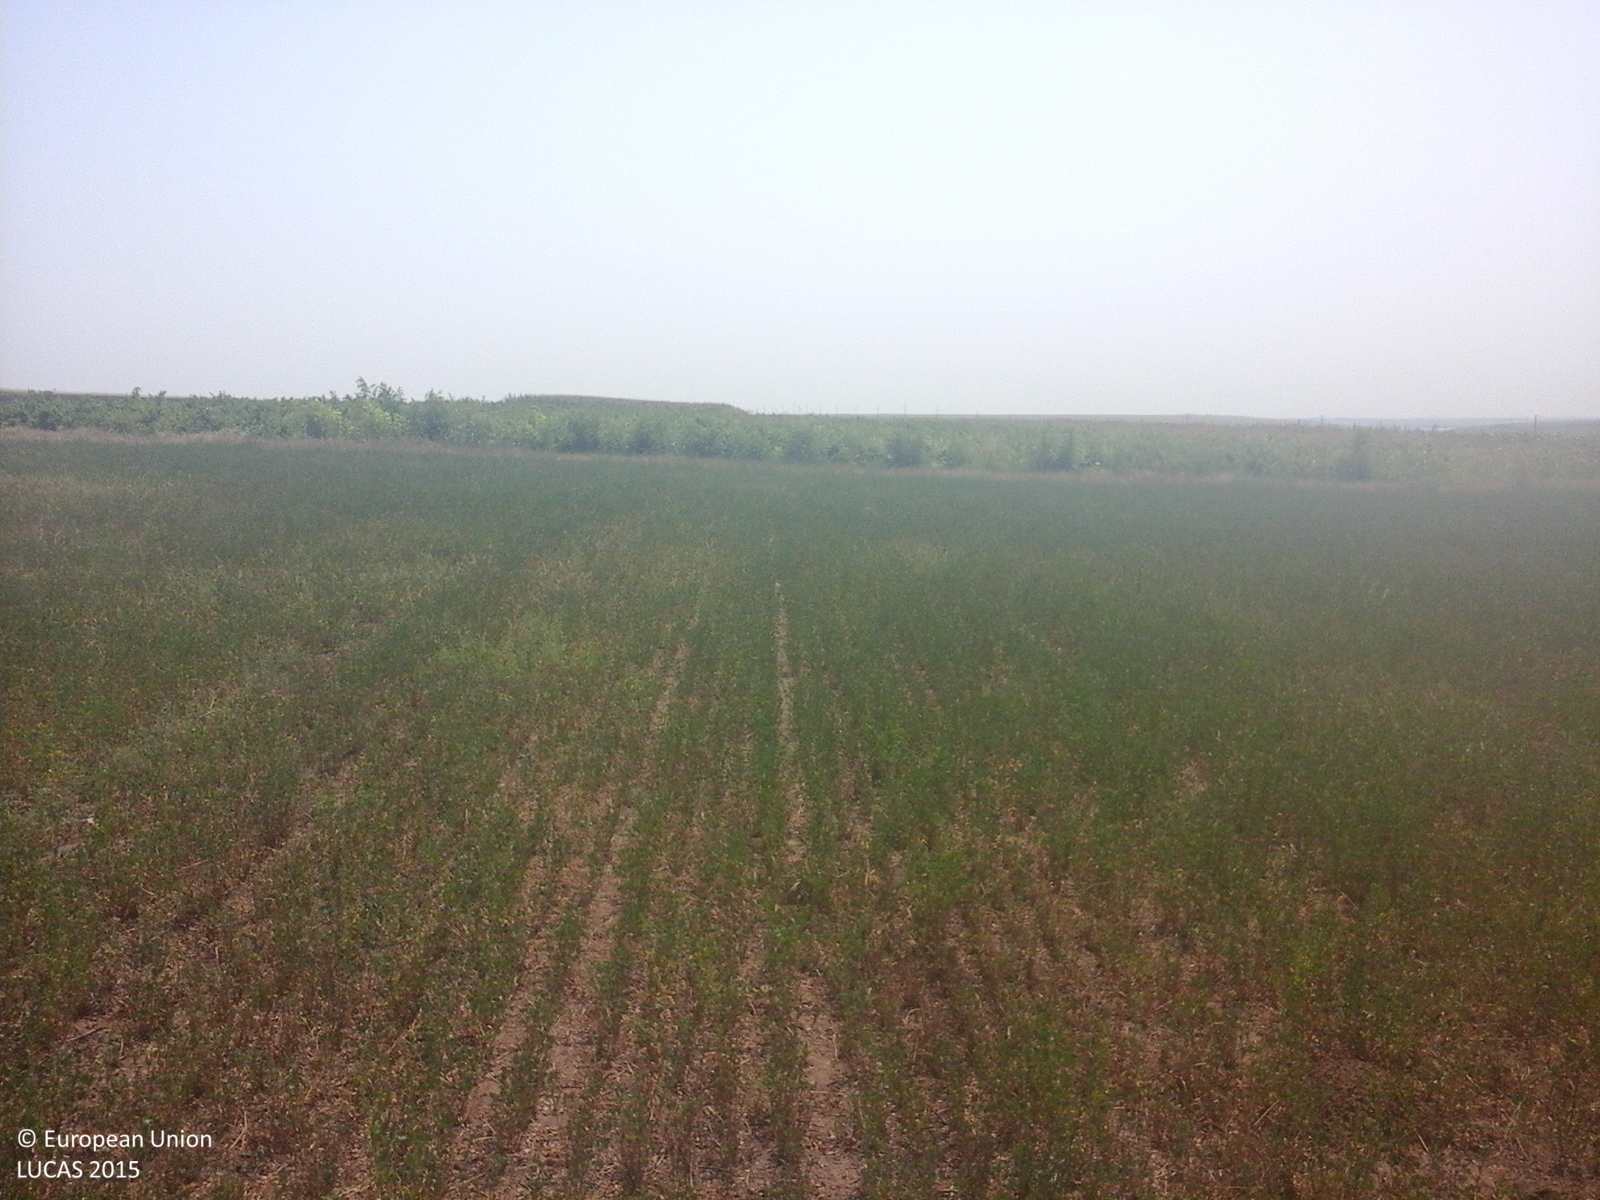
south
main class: Cropland
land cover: Lucerne
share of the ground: > 75 %
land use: Agriculture (excluding fallow land and kitchen gardens)
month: July
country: RO
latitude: 45.4953
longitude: 27.8622
